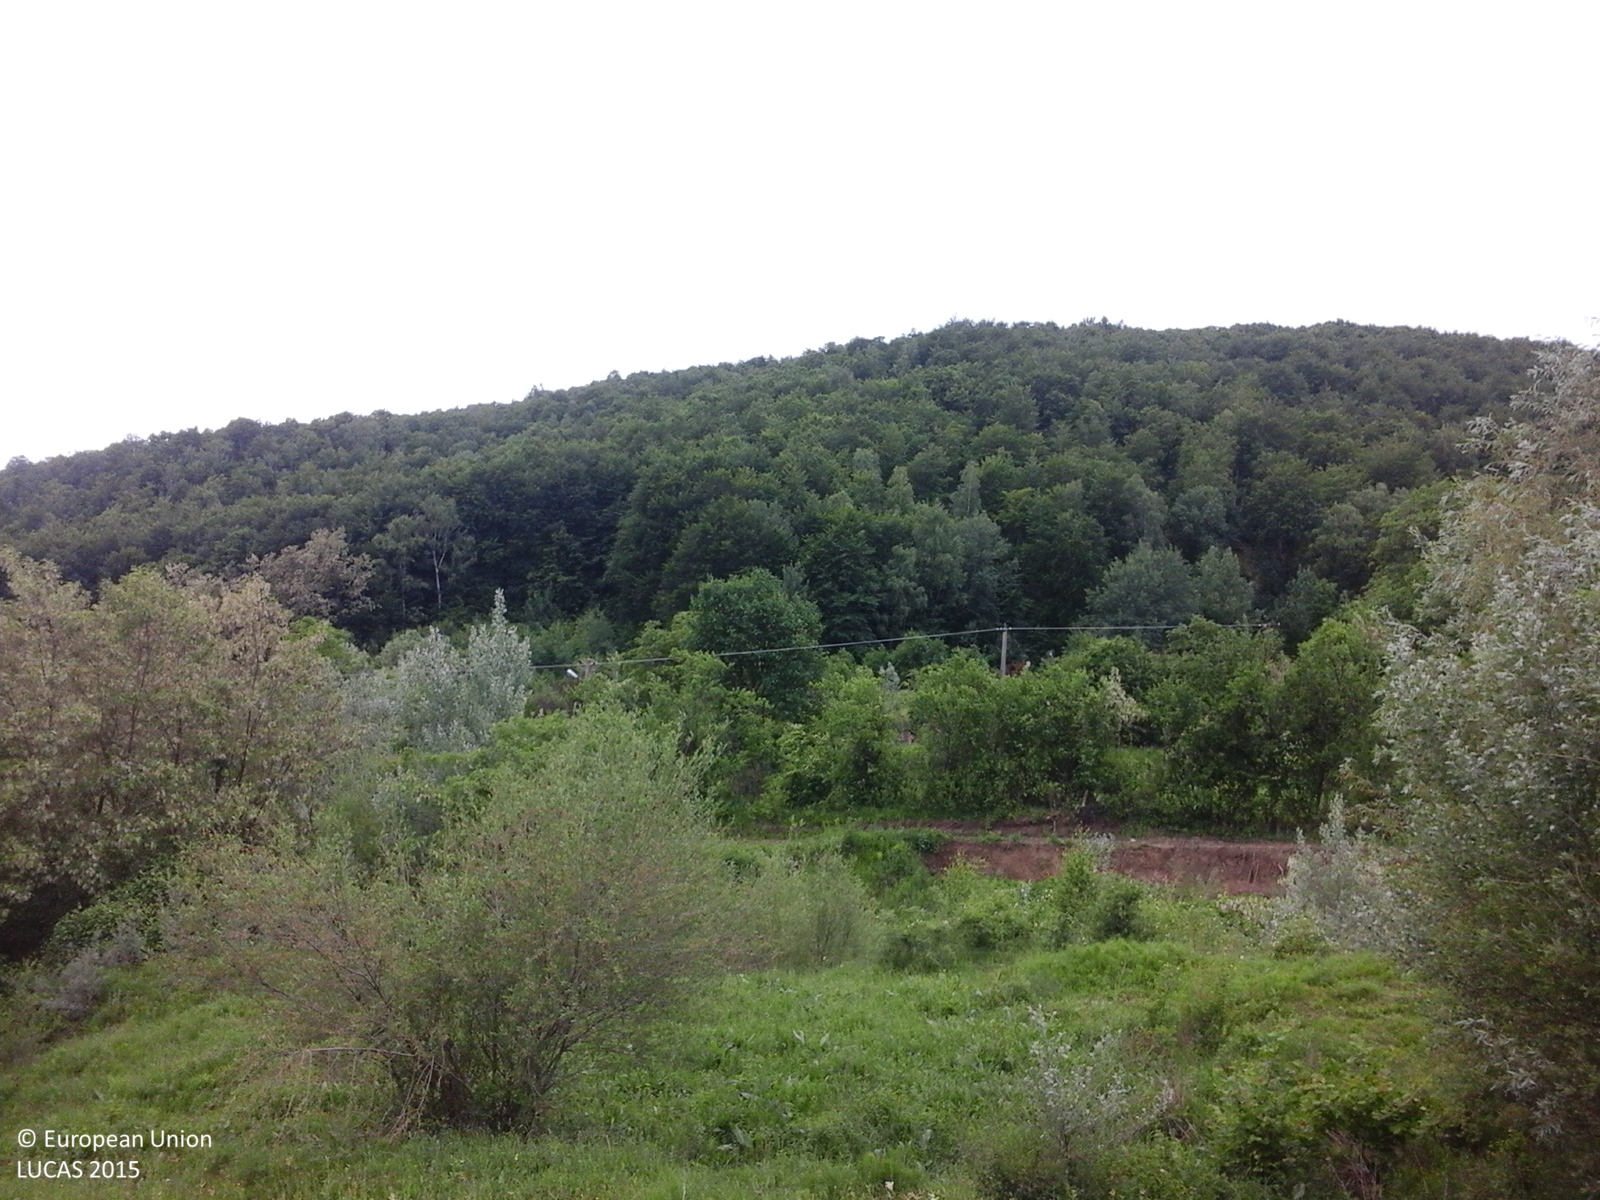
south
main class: Grassland
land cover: Grassland with sparse tree/shrub cover
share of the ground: > 75 %
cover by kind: herbaceous plants 85 %, shrubs 10 %, broadleaved forest trees 5 %
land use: Agriculture (excluding fallow land and kitchen gardens)
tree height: < 5 m
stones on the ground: < 10 %
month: May
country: RO
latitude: 45.1967
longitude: 26.0877
